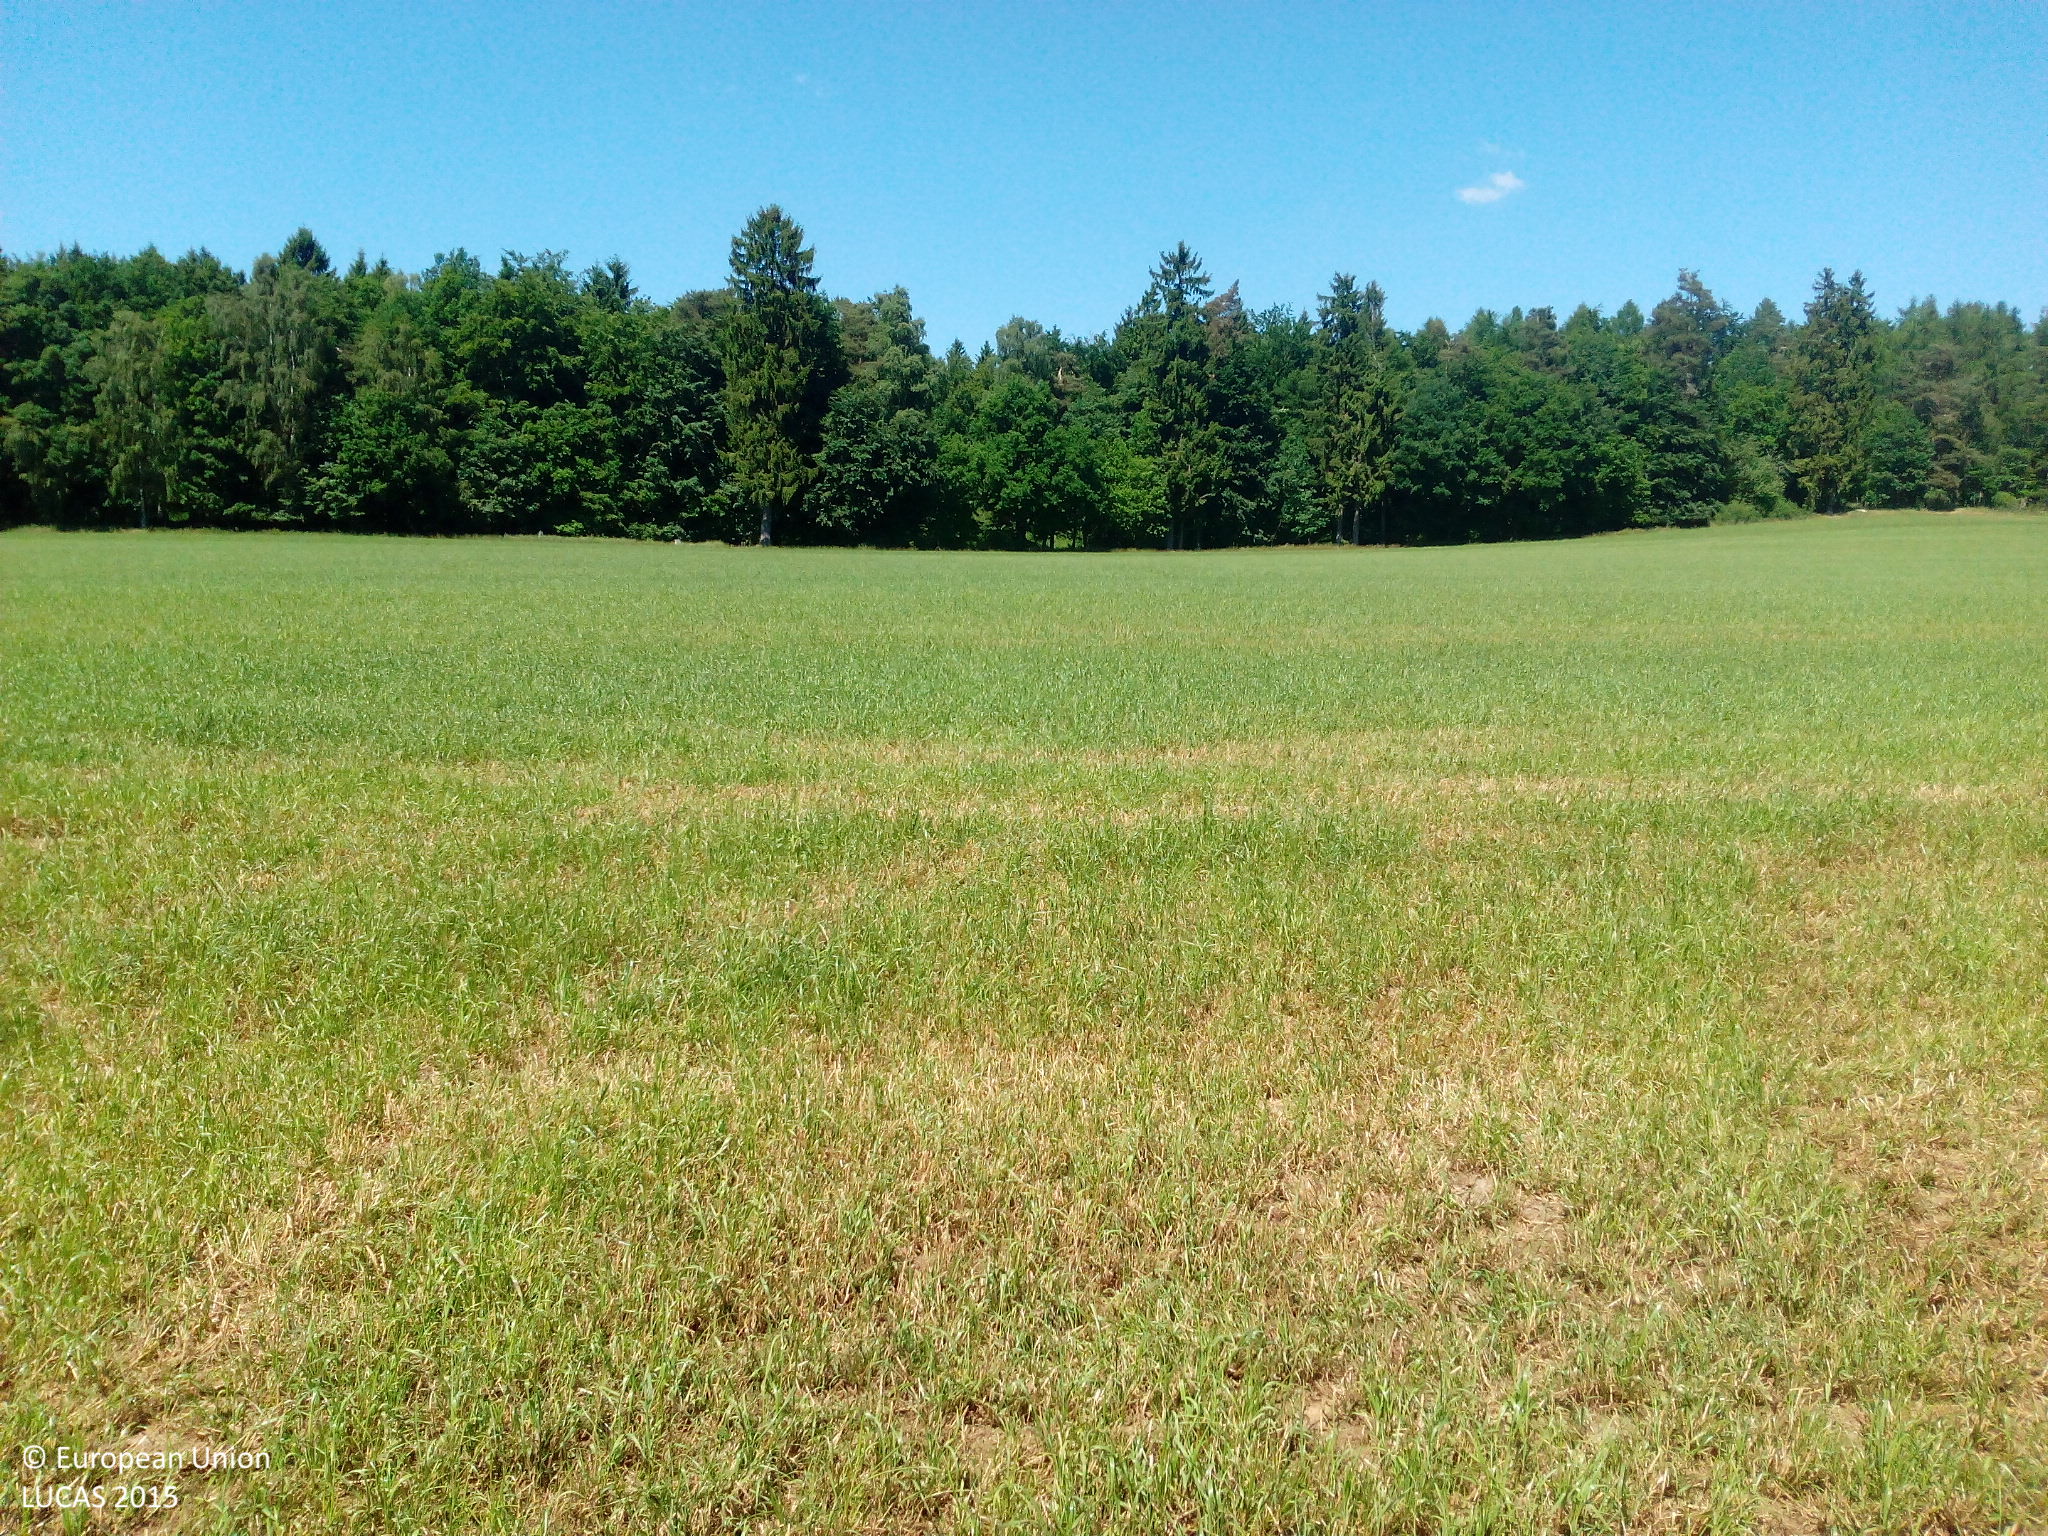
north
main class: Cropland
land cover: Temporary grasslands
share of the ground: > 75 %
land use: Agriculture (excluding fallow land and kitchen gardens)
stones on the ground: < 10 %
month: June
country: DE
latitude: 53.3772
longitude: 12.4496
